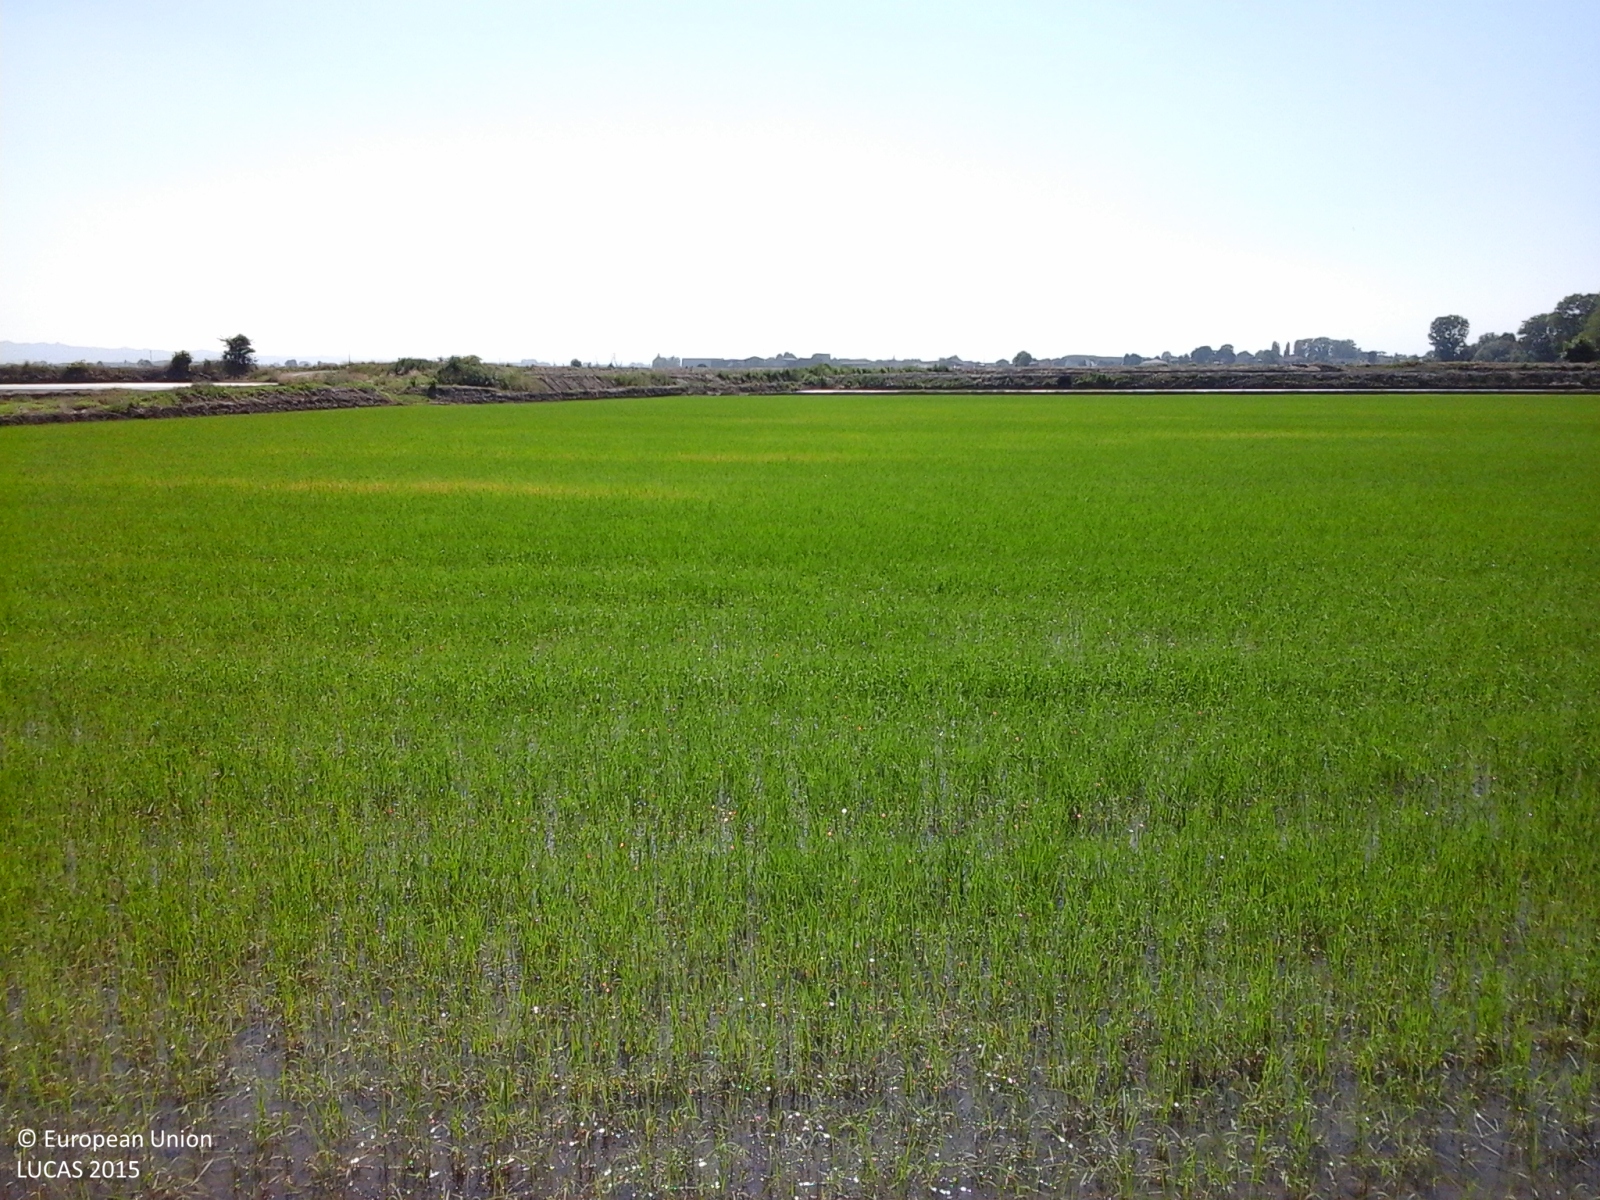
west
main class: Cropland
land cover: Rice
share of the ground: 50 - 75 %
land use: Agriculture (excluding fallow land and kitchen gardens)
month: May
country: IT
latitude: 45.2585
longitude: 8.4353
